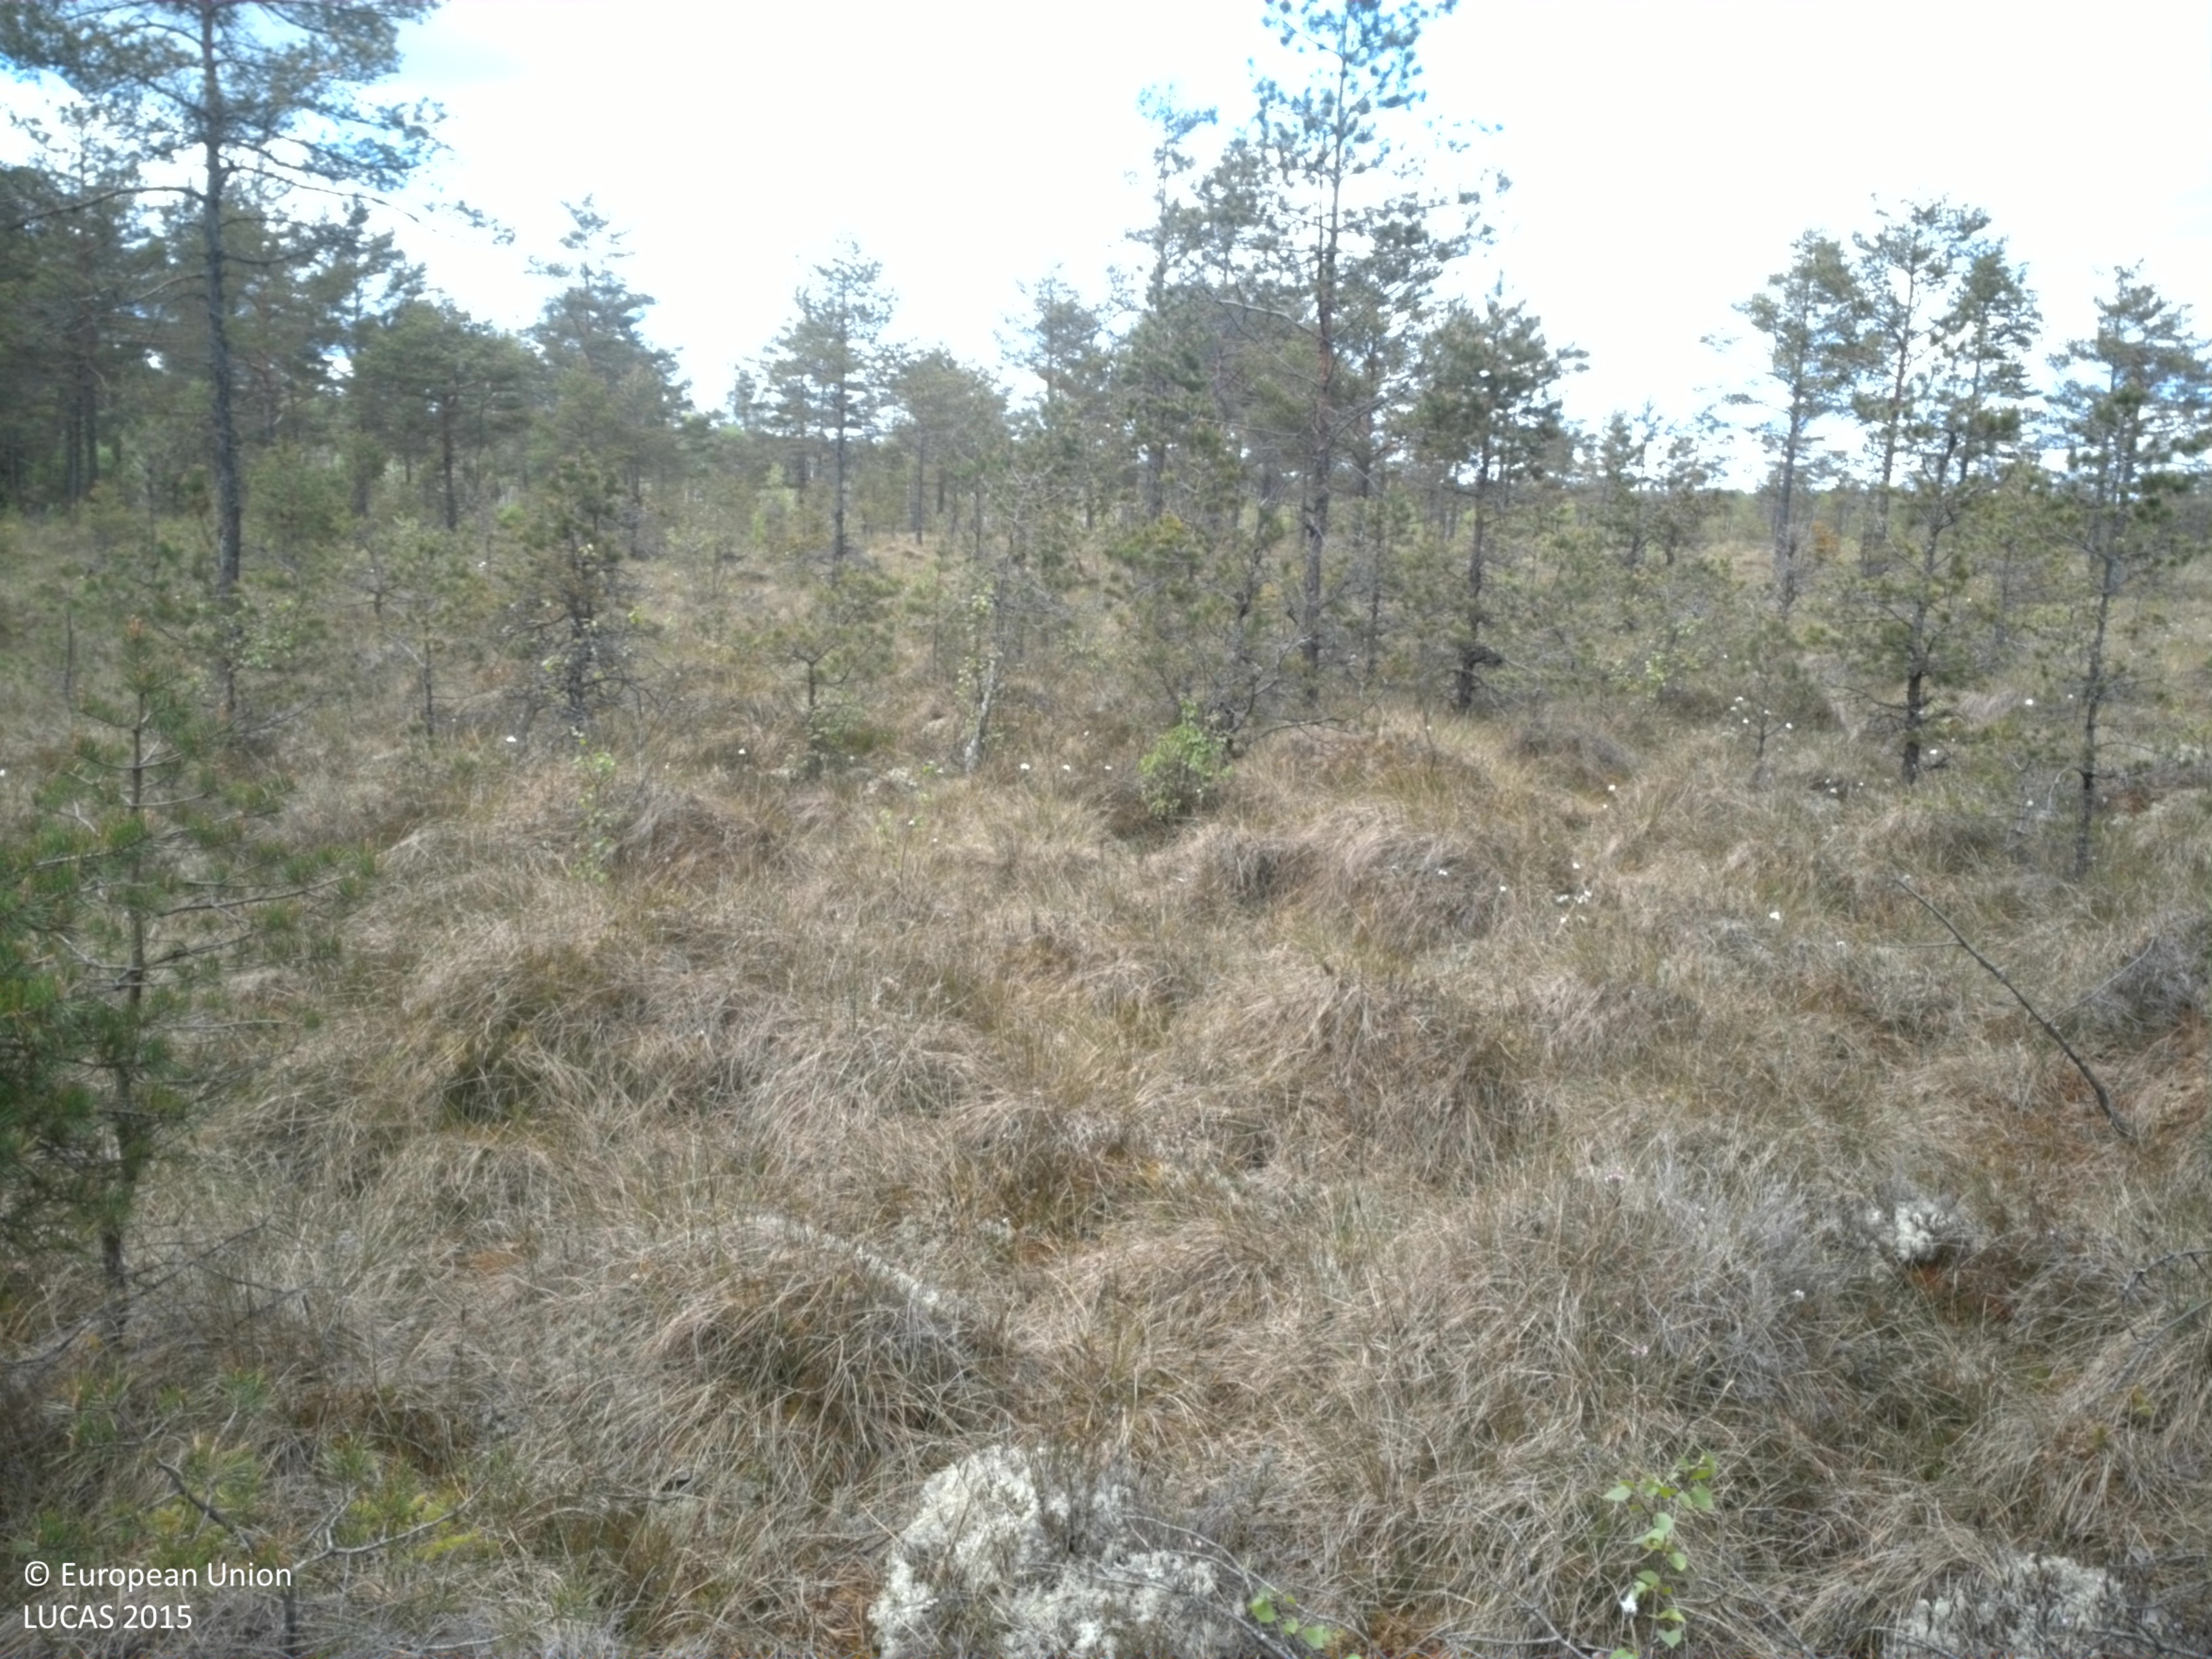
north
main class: Woodland
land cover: Pine dominated coniferous woodland
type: mire and swamp forests
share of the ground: > 75 %
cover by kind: coniferous forest trees 50 %, herbaceous plants 25 %, lichens and mosses 25 %
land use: Semi-natural and natural areas not in use
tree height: > 5 m
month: May
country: SE
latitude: 56.5757
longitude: 15.0279
